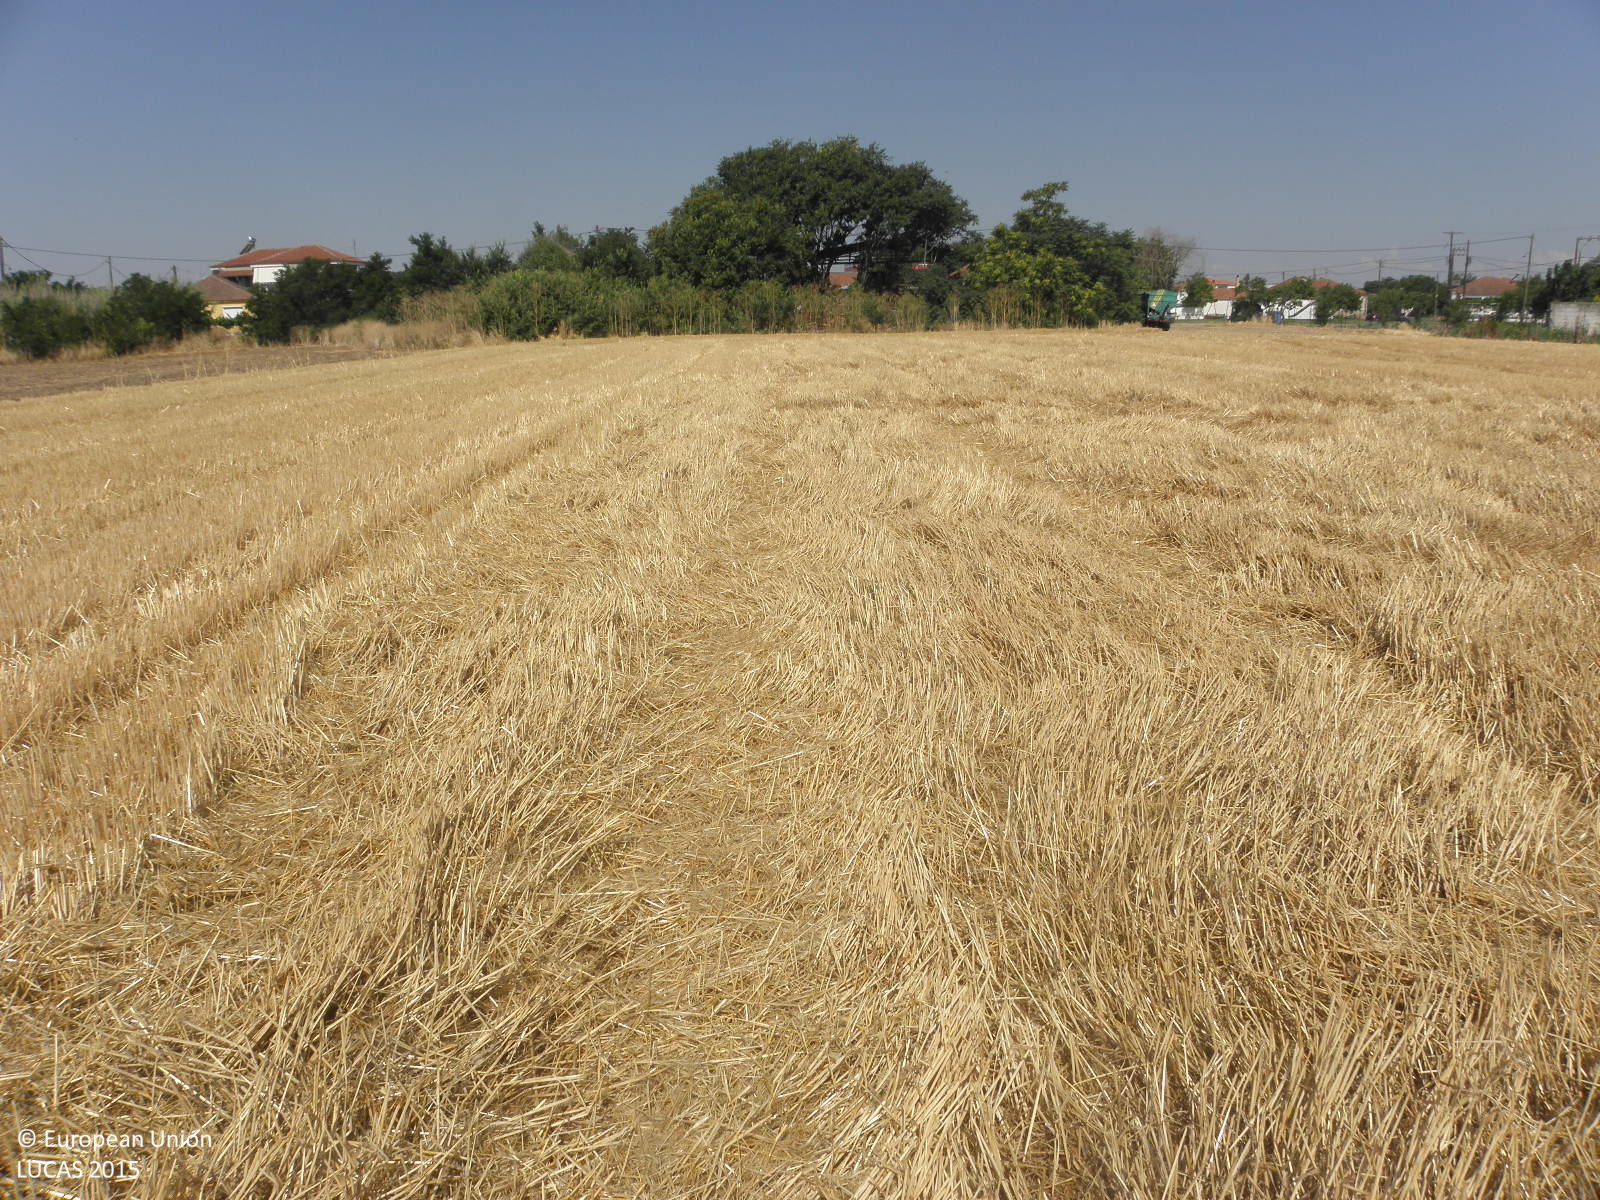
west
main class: Cropland
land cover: Durum wheat
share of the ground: > 75 %
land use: Agriculture (excluding fallow land and kitchen gardens)
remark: Harvested field
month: June
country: GR
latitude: 39.6242
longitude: 22.5375
